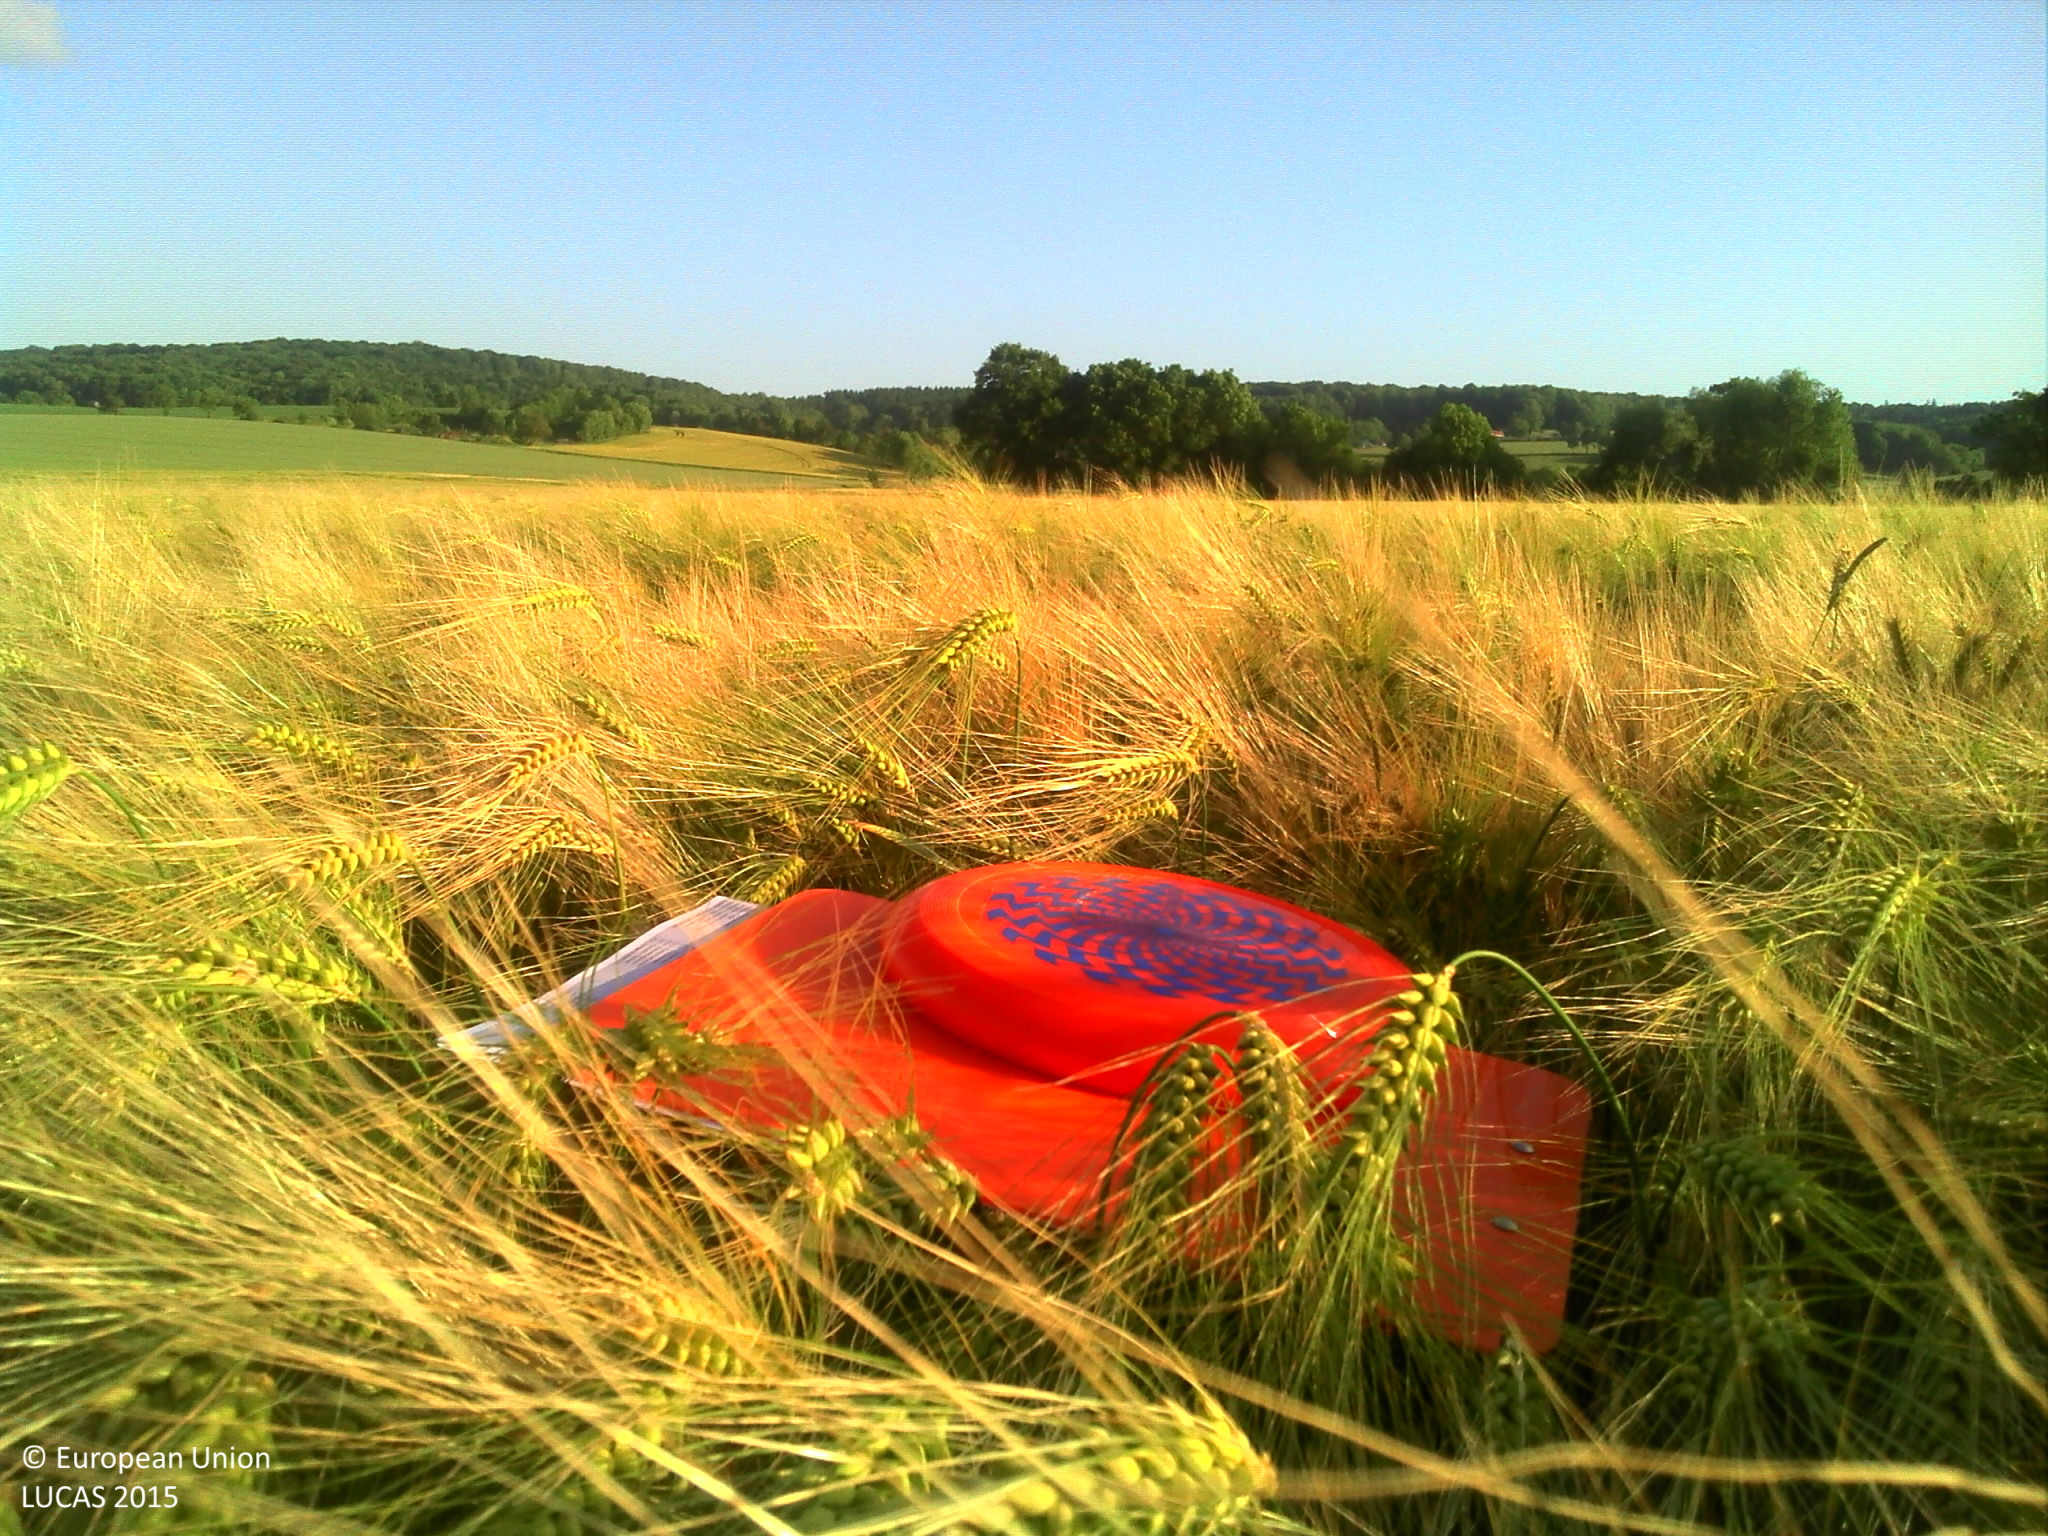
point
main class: Cropland
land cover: Barley
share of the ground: > 75 %
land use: Agriculture (excluding fallow land and kitchen gardens)
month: June
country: FR
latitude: 48.7897
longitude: 0.0749
